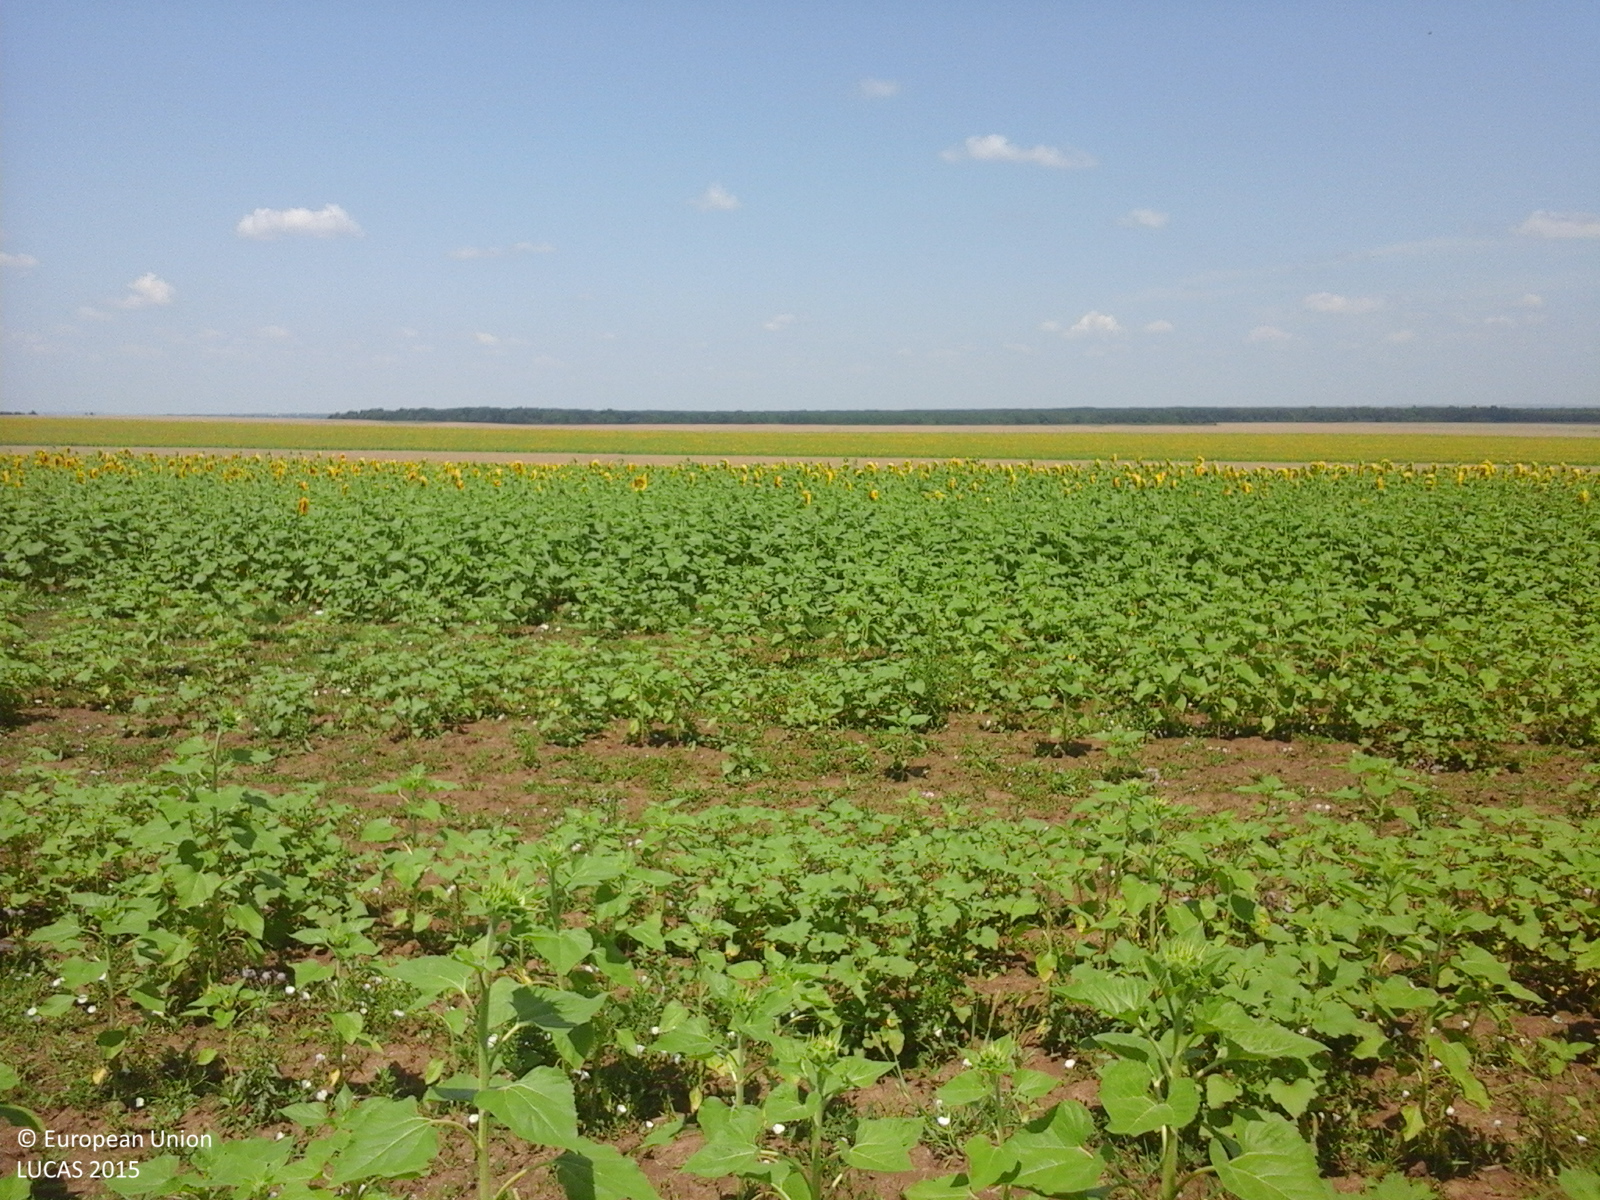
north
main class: Cropland
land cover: Sunflower
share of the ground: 25 - 50 %
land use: Agriculture (excluding fallow land and kitchen gardens)
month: July
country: RO
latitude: 44.1970
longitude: 24.2909
